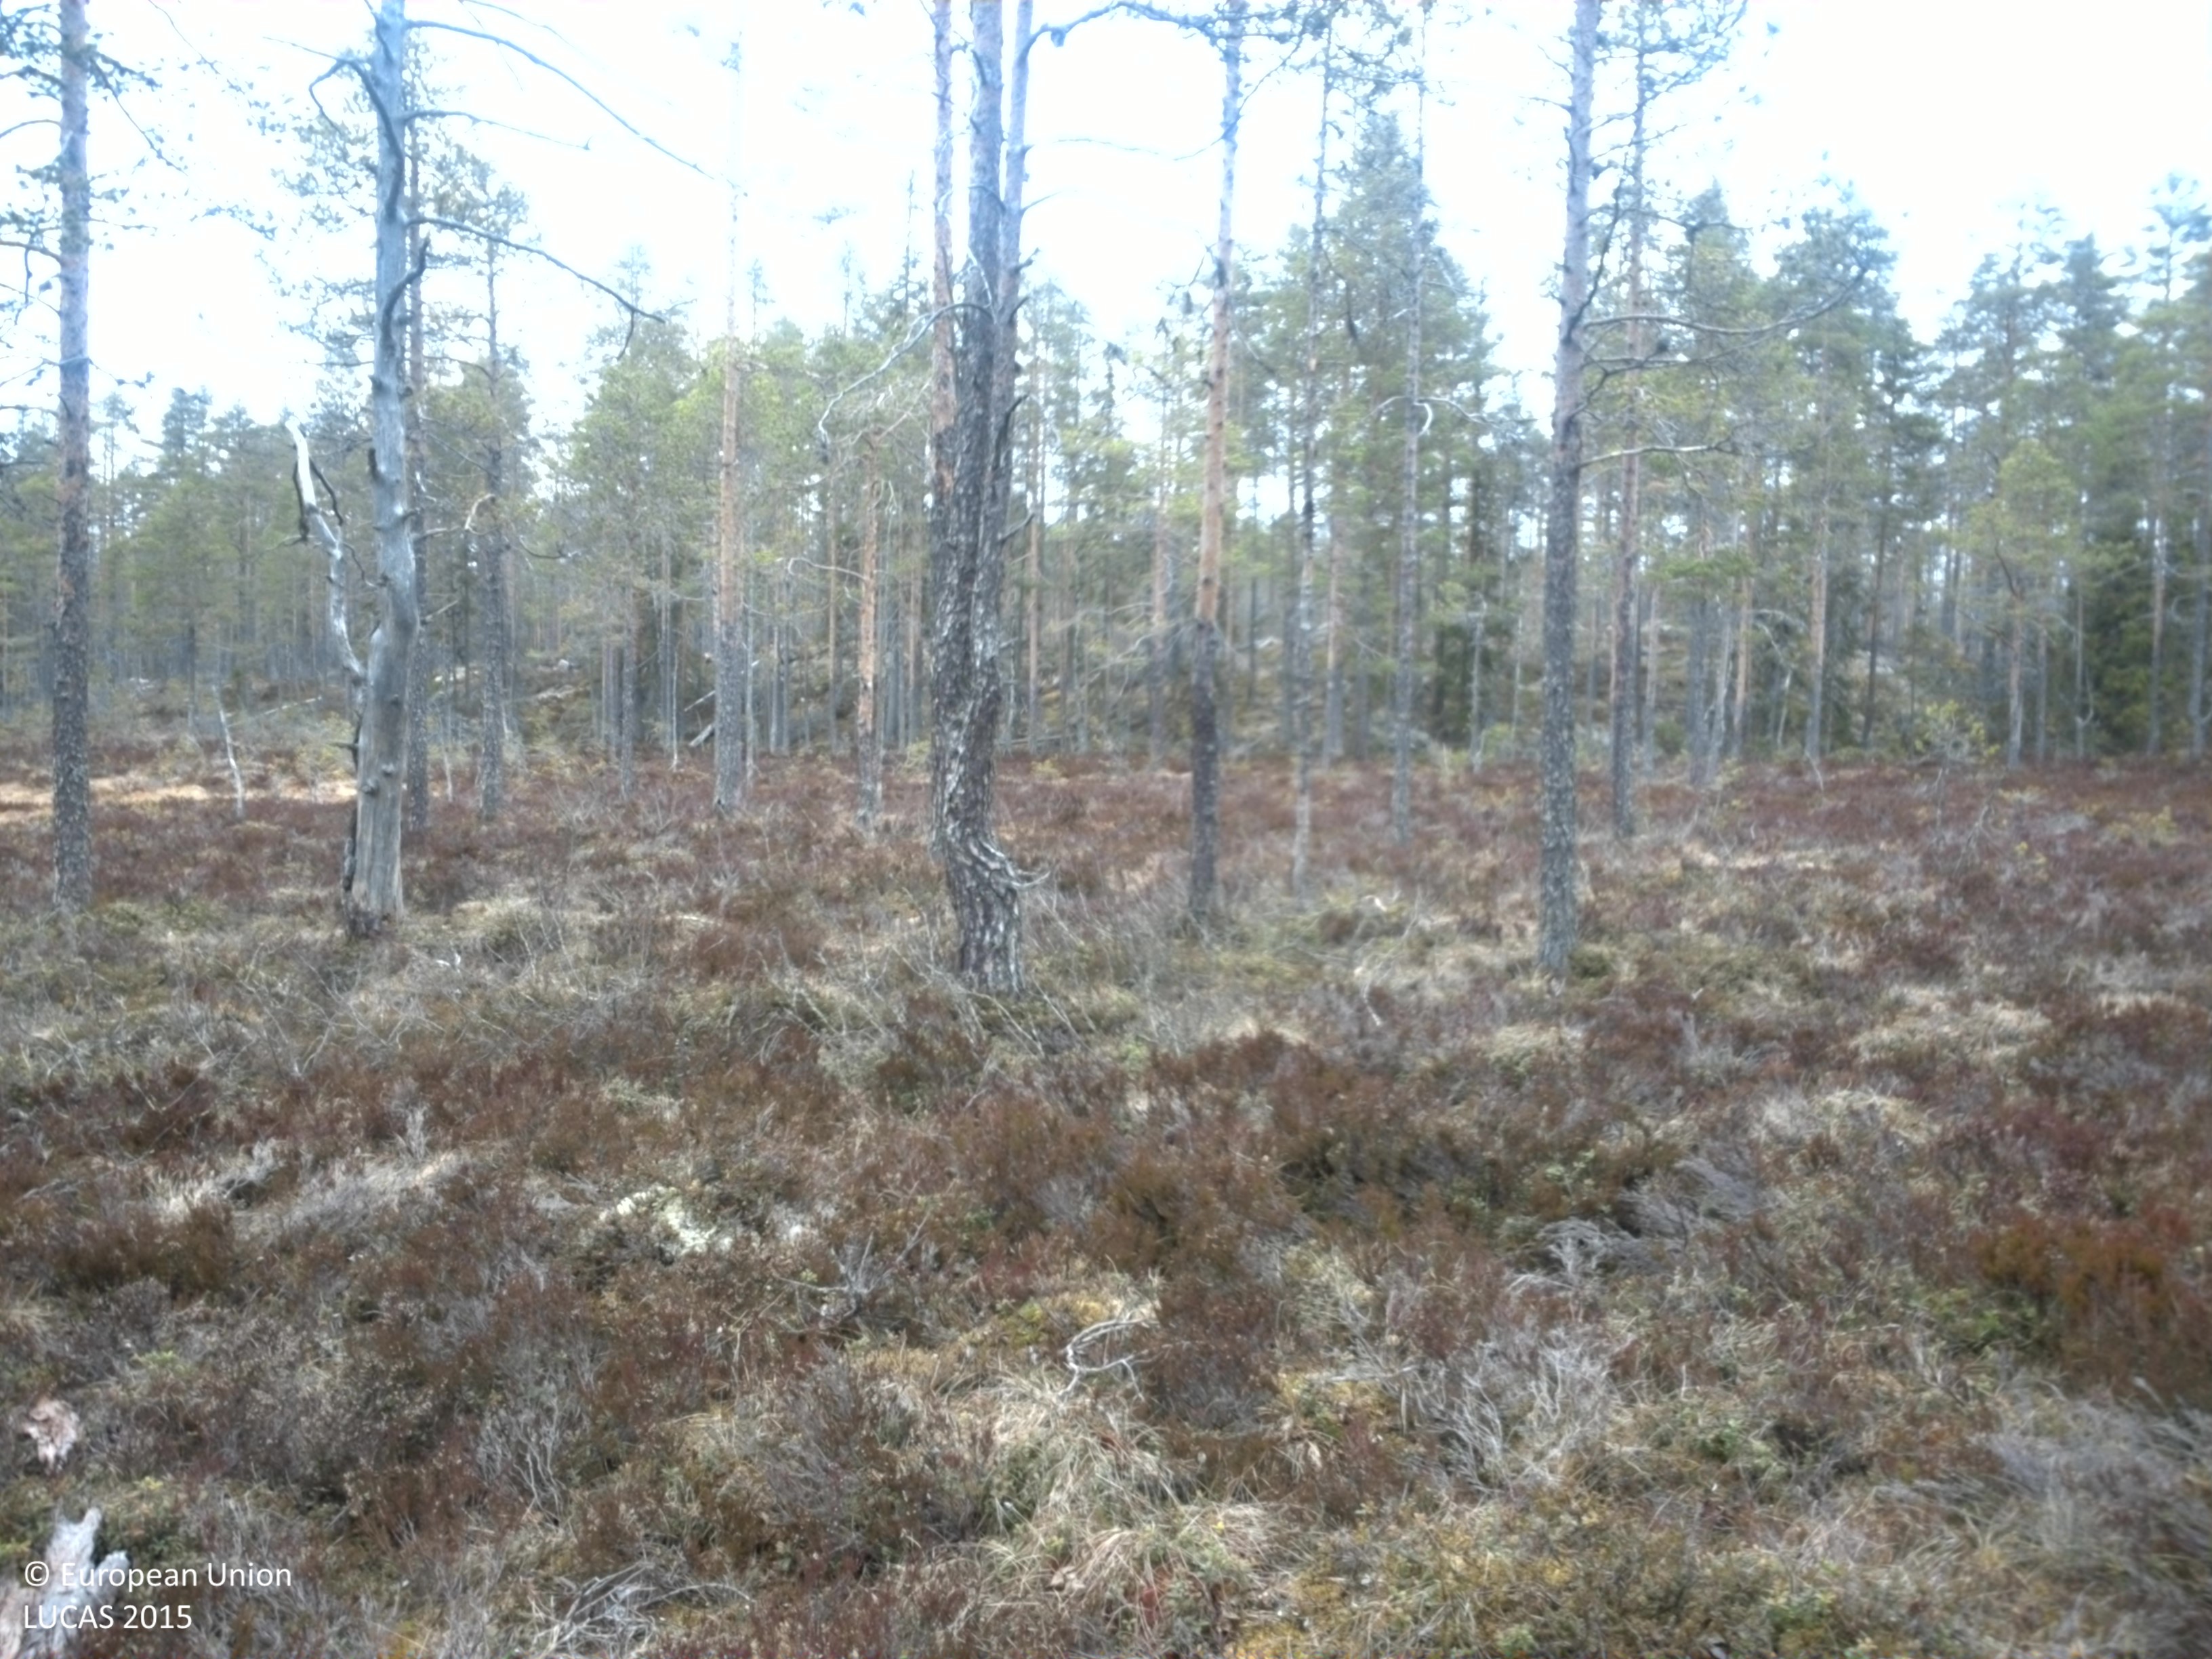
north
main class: Woodland
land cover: Pine dominated coniferous woodland
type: boreal forest
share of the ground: 25 - 50 %
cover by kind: coniferous forest trees 45 %, shrubs 25 %, lichens and mosses 25 %, herbaceous plants 5 %
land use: Forestry
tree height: > 5 m
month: May
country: SE
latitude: 60.9163
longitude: 13.3272
